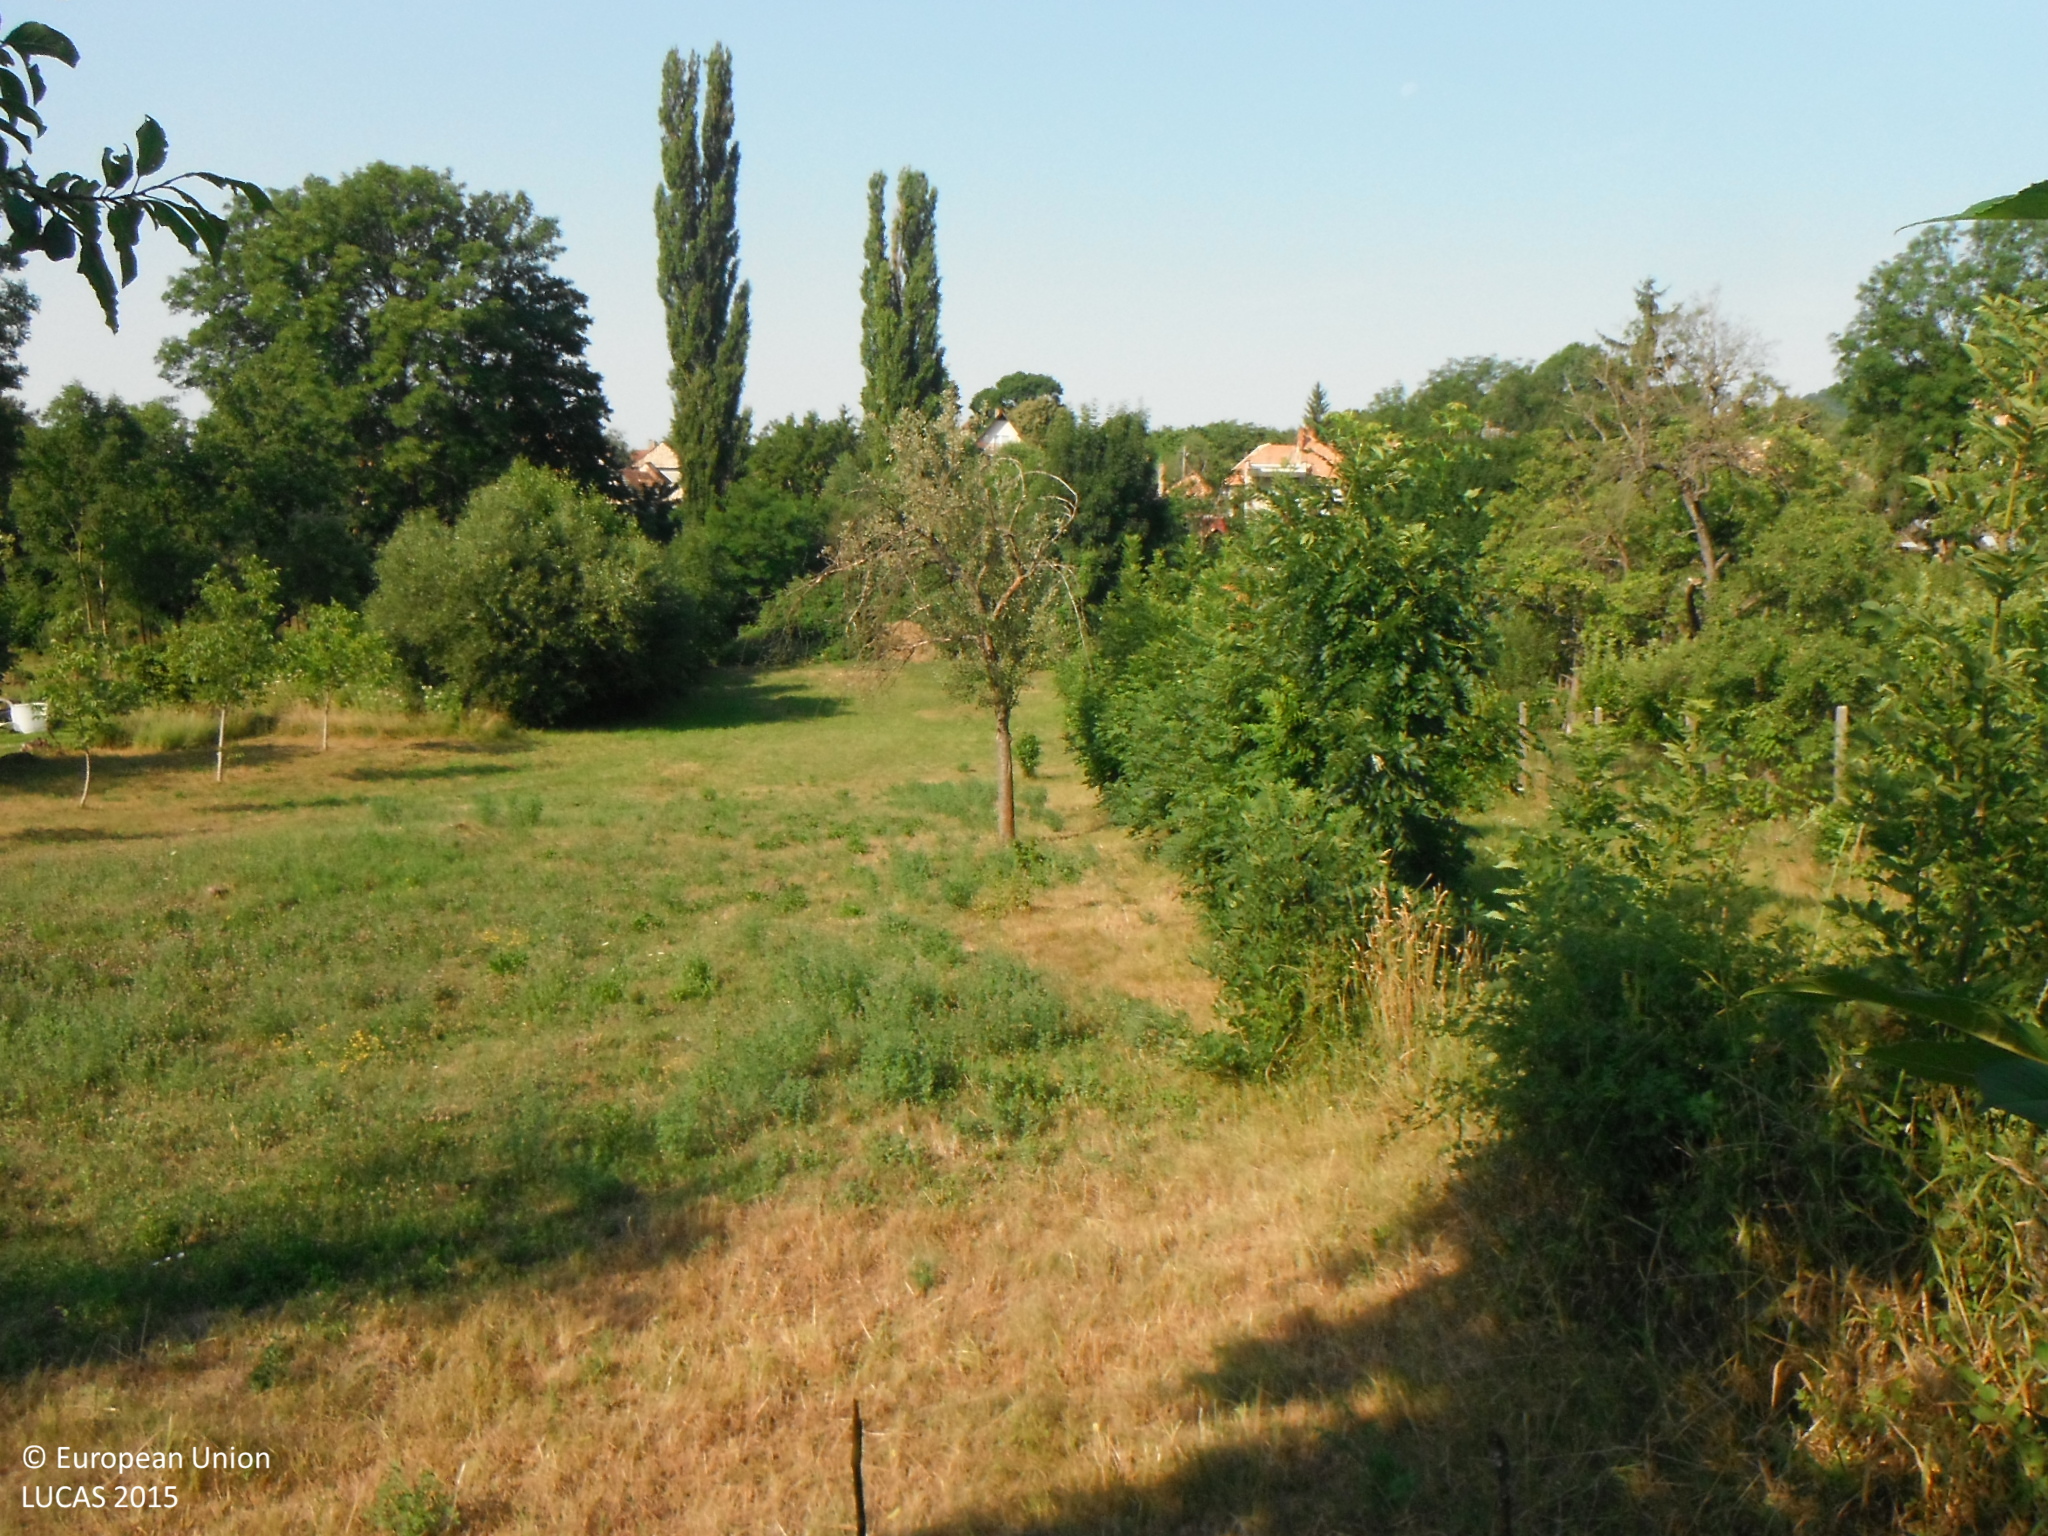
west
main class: Grassland
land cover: Grassland without tree/shrub cover
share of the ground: > 75 %
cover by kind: herbaceous plants 100 %
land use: Residential
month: July
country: SK
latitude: 48.1949
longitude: 19.2643
